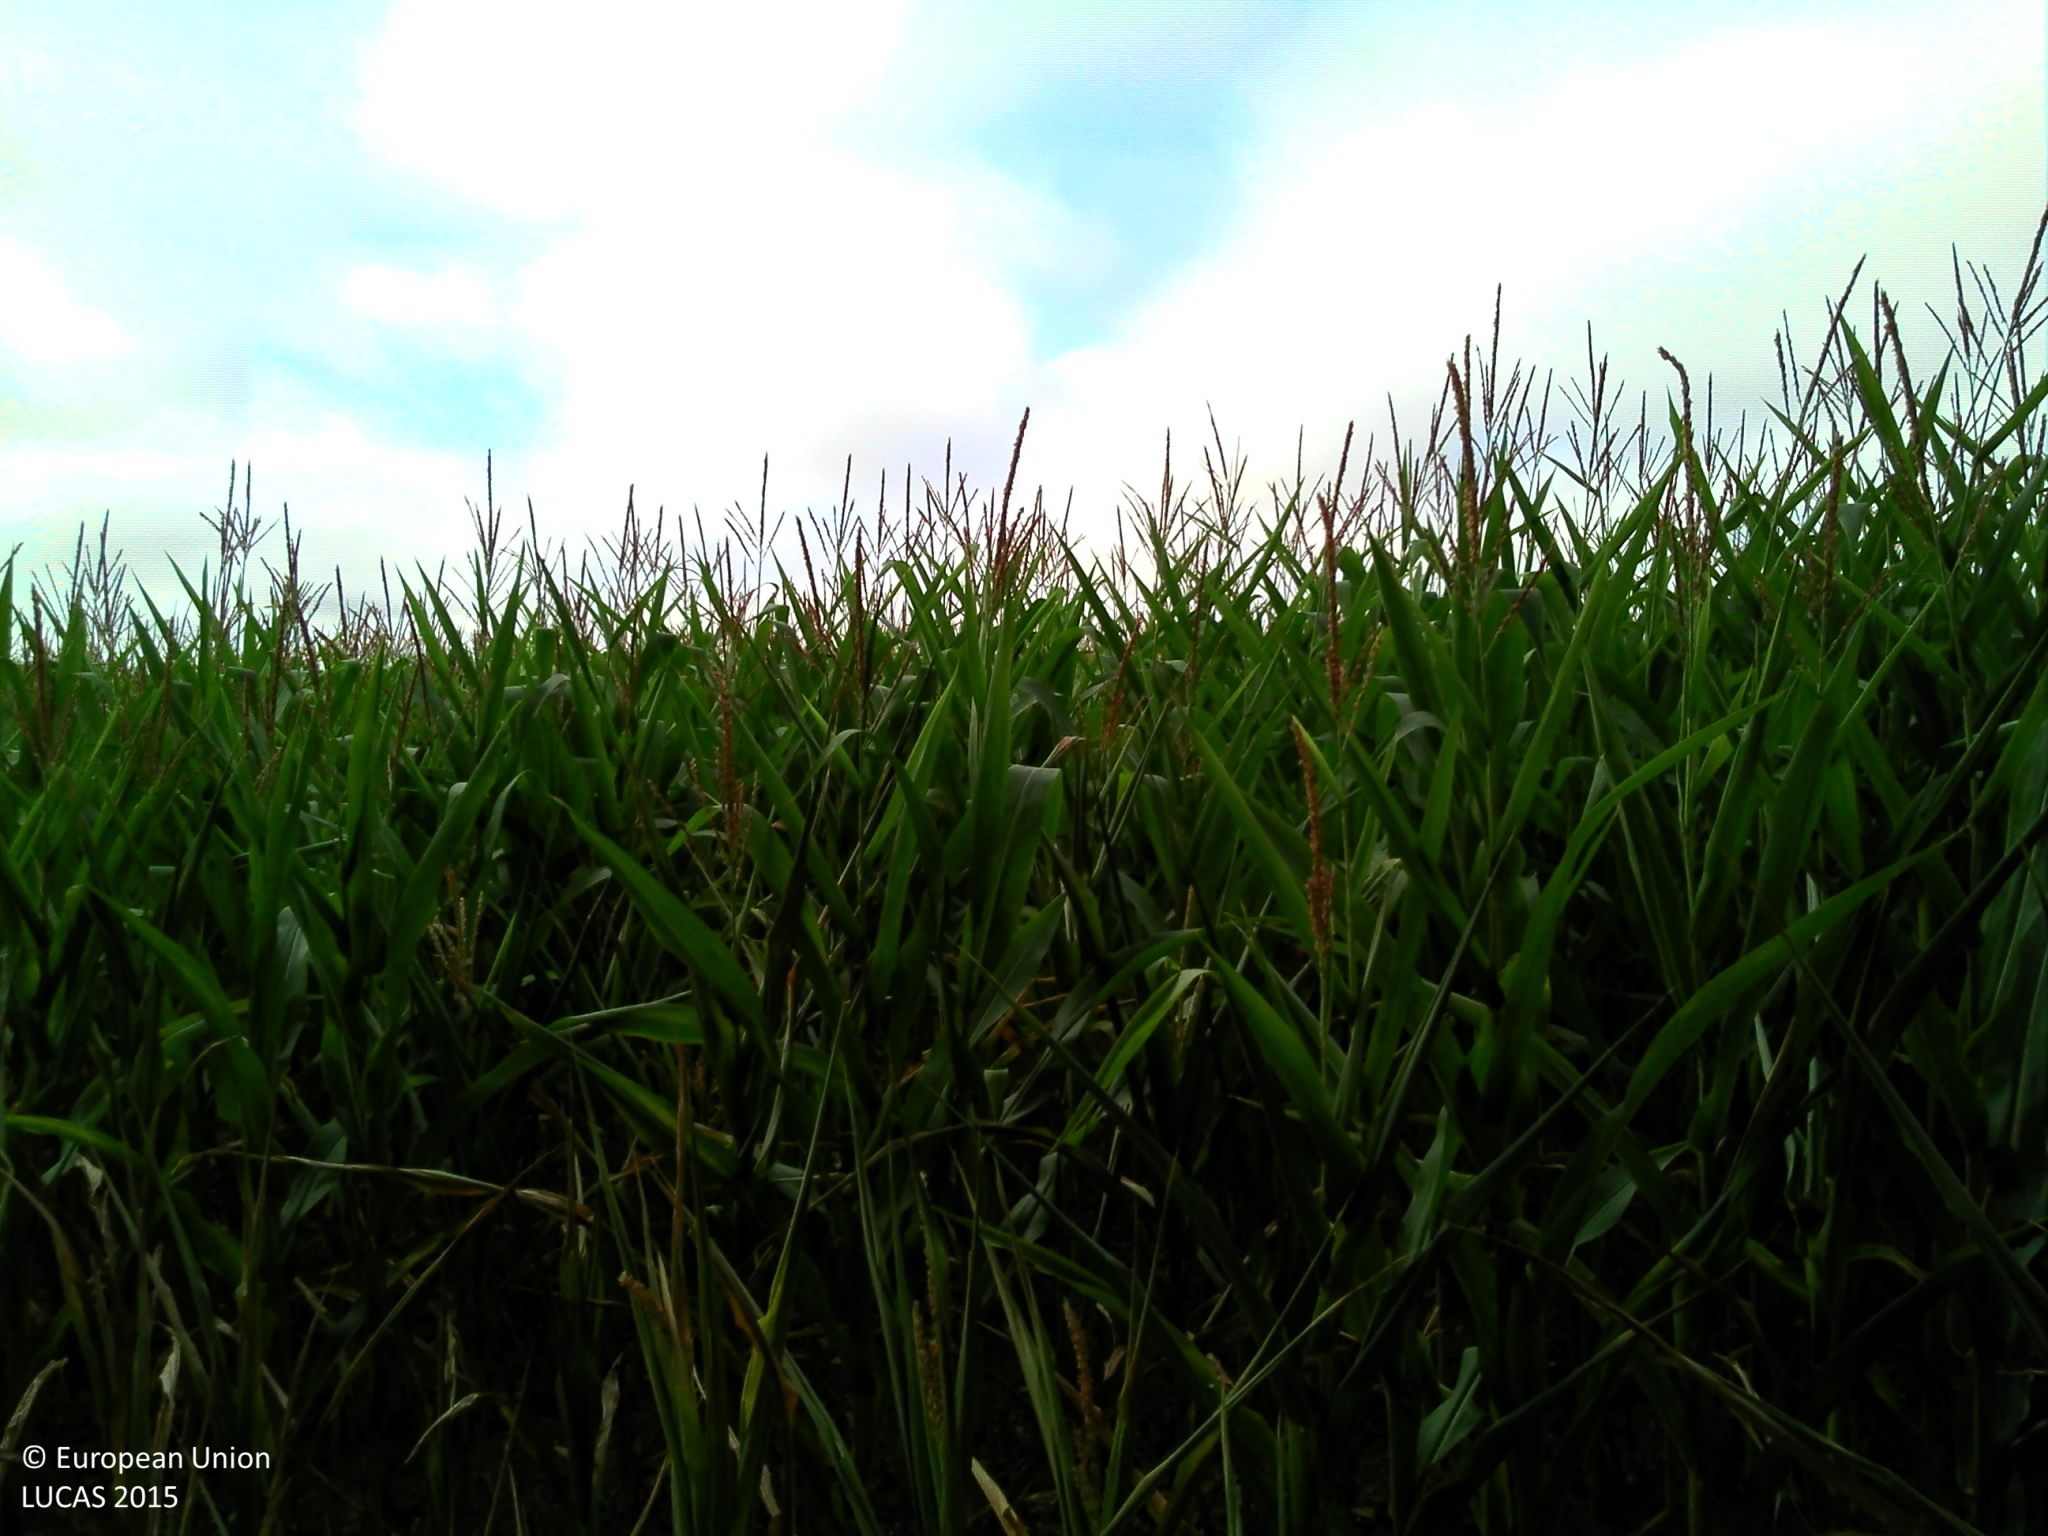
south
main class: Cropland
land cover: Maize
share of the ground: > 75 %
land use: Agriculture (excluding fallow land and kitchen gardens)
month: July
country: FR
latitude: 46.2718
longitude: 0.4980
